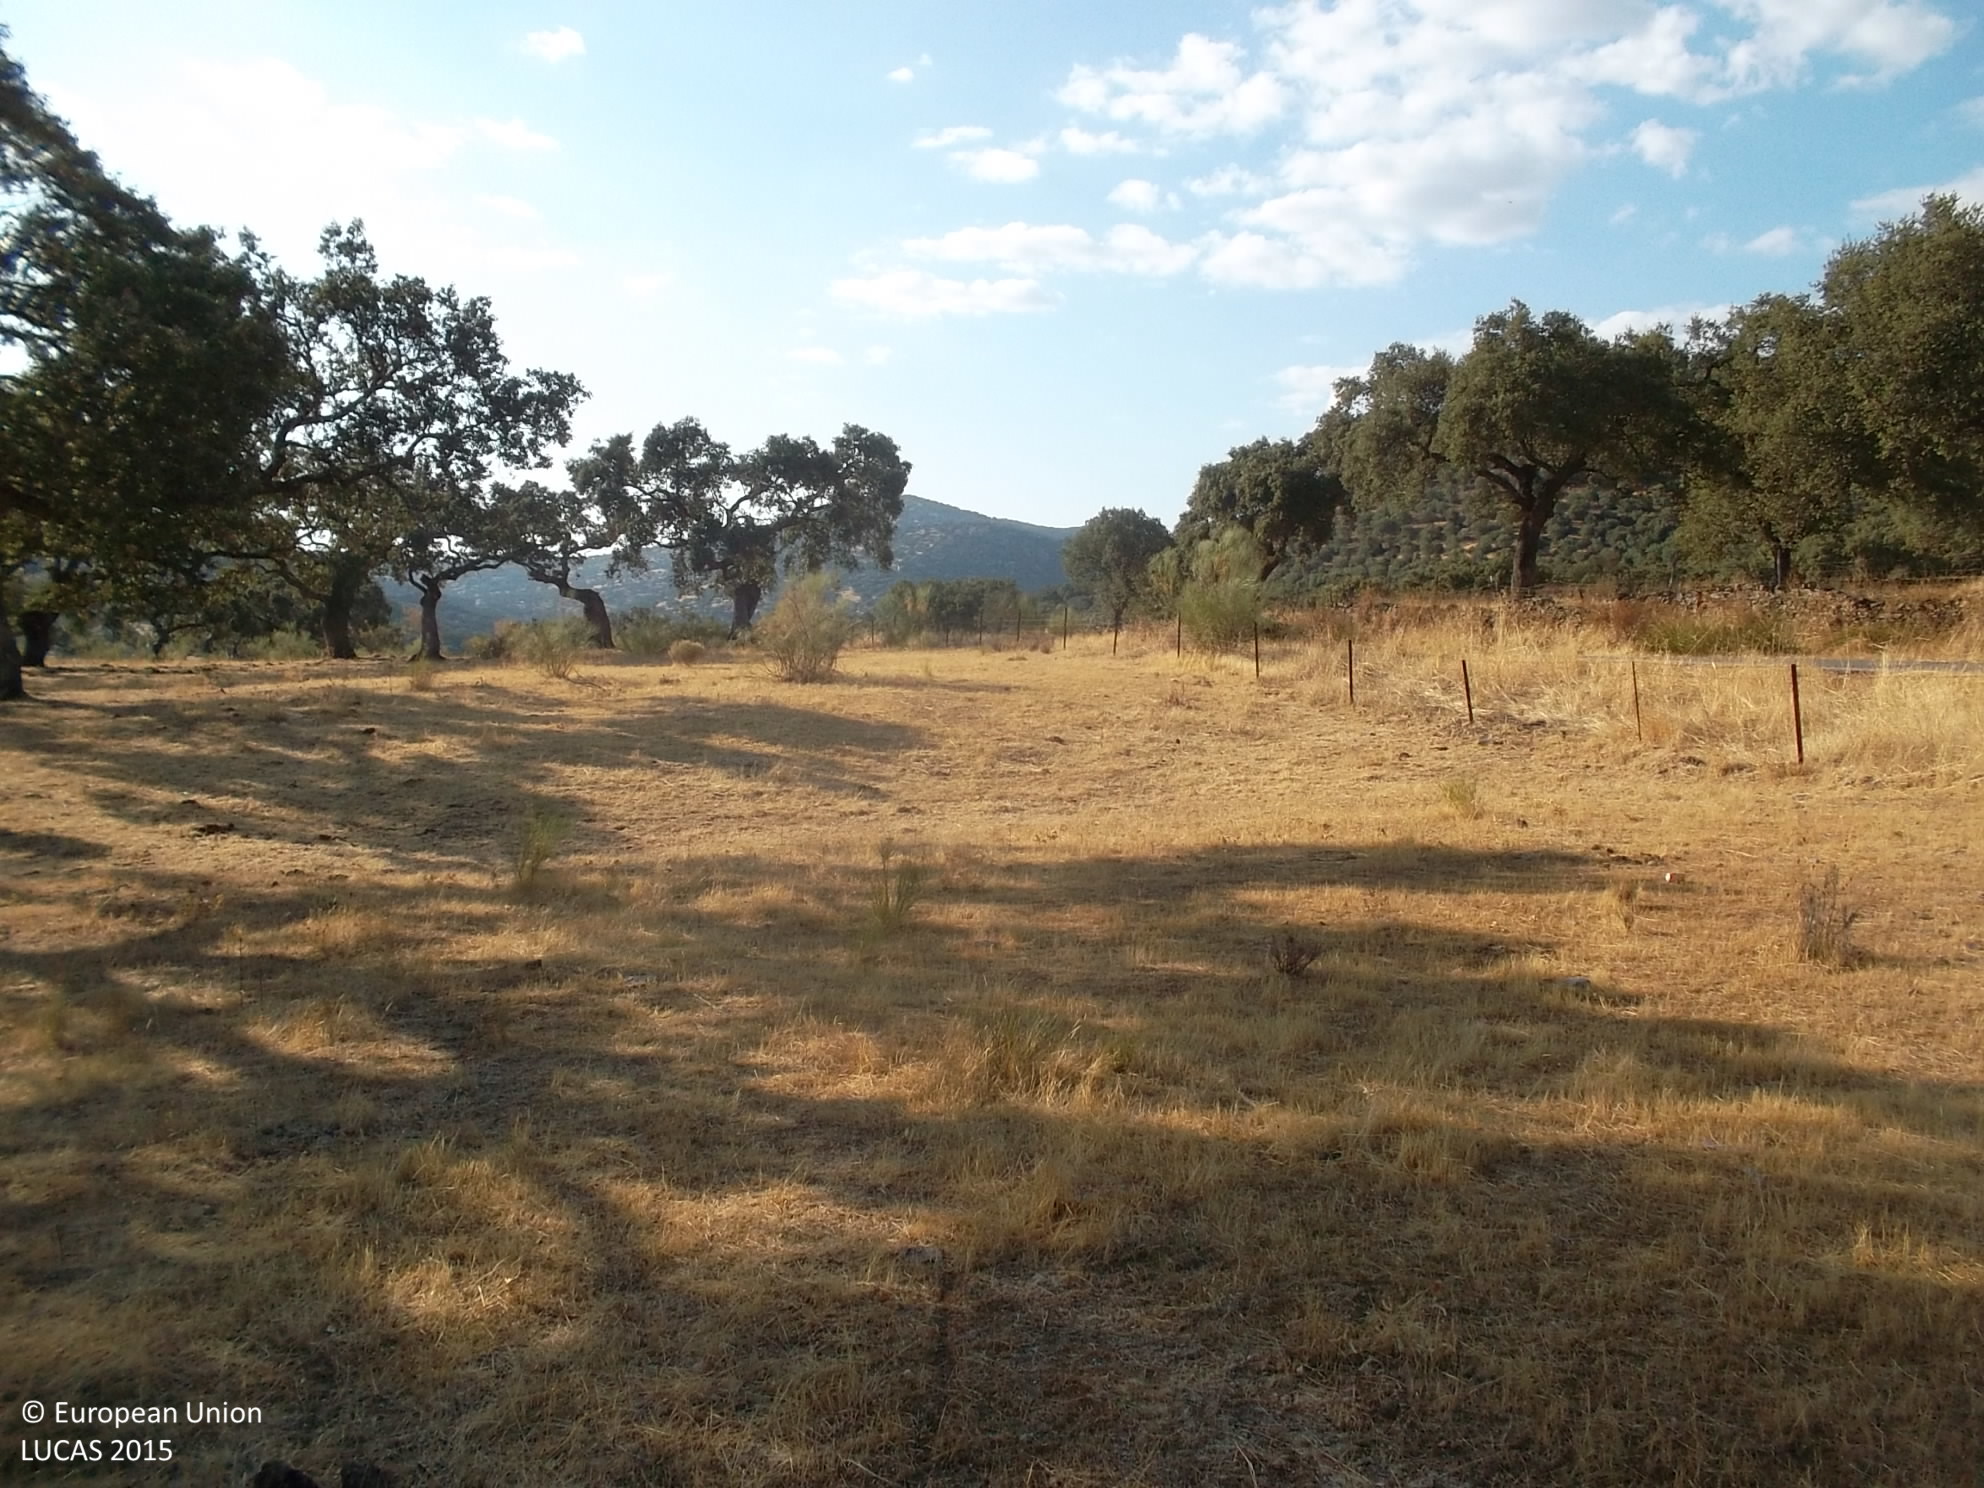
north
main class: Woodland
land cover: Broadleaved woodland
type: broadleaved evergreen forest
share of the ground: 25 - 50 %
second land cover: Grassland without tree/shrub cover
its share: > 75 %
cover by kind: herbaceous plants 75 %, broadleaved forest trees 25 %
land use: Forestry
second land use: Agriculture (excluding fallow land and kitchen gardens)
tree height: > 5 m
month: September
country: ES
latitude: 38.0149
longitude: -6.4802
